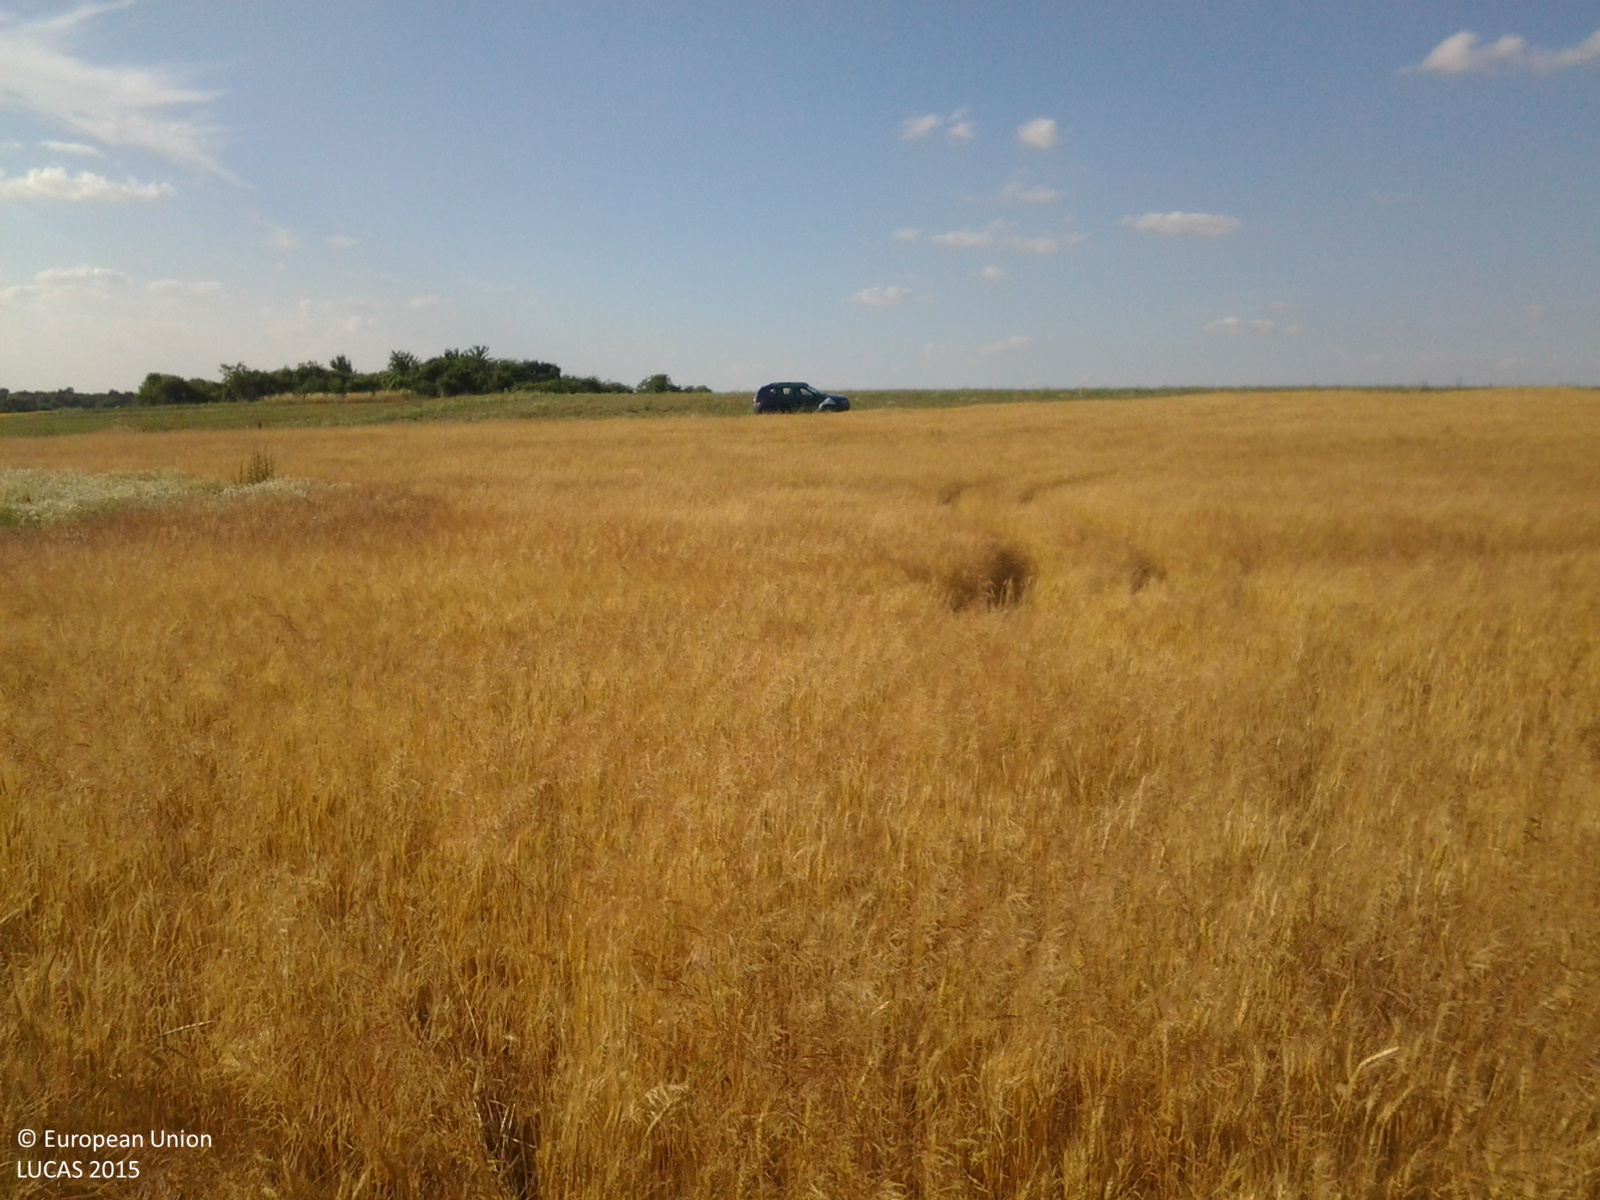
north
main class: Cropland
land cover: Common wheat
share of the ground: > 75 %
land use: Agriculture (excluding fallow land and kitchen gardens)
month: June
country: HU
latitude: 47.2092
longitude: 17.4931
